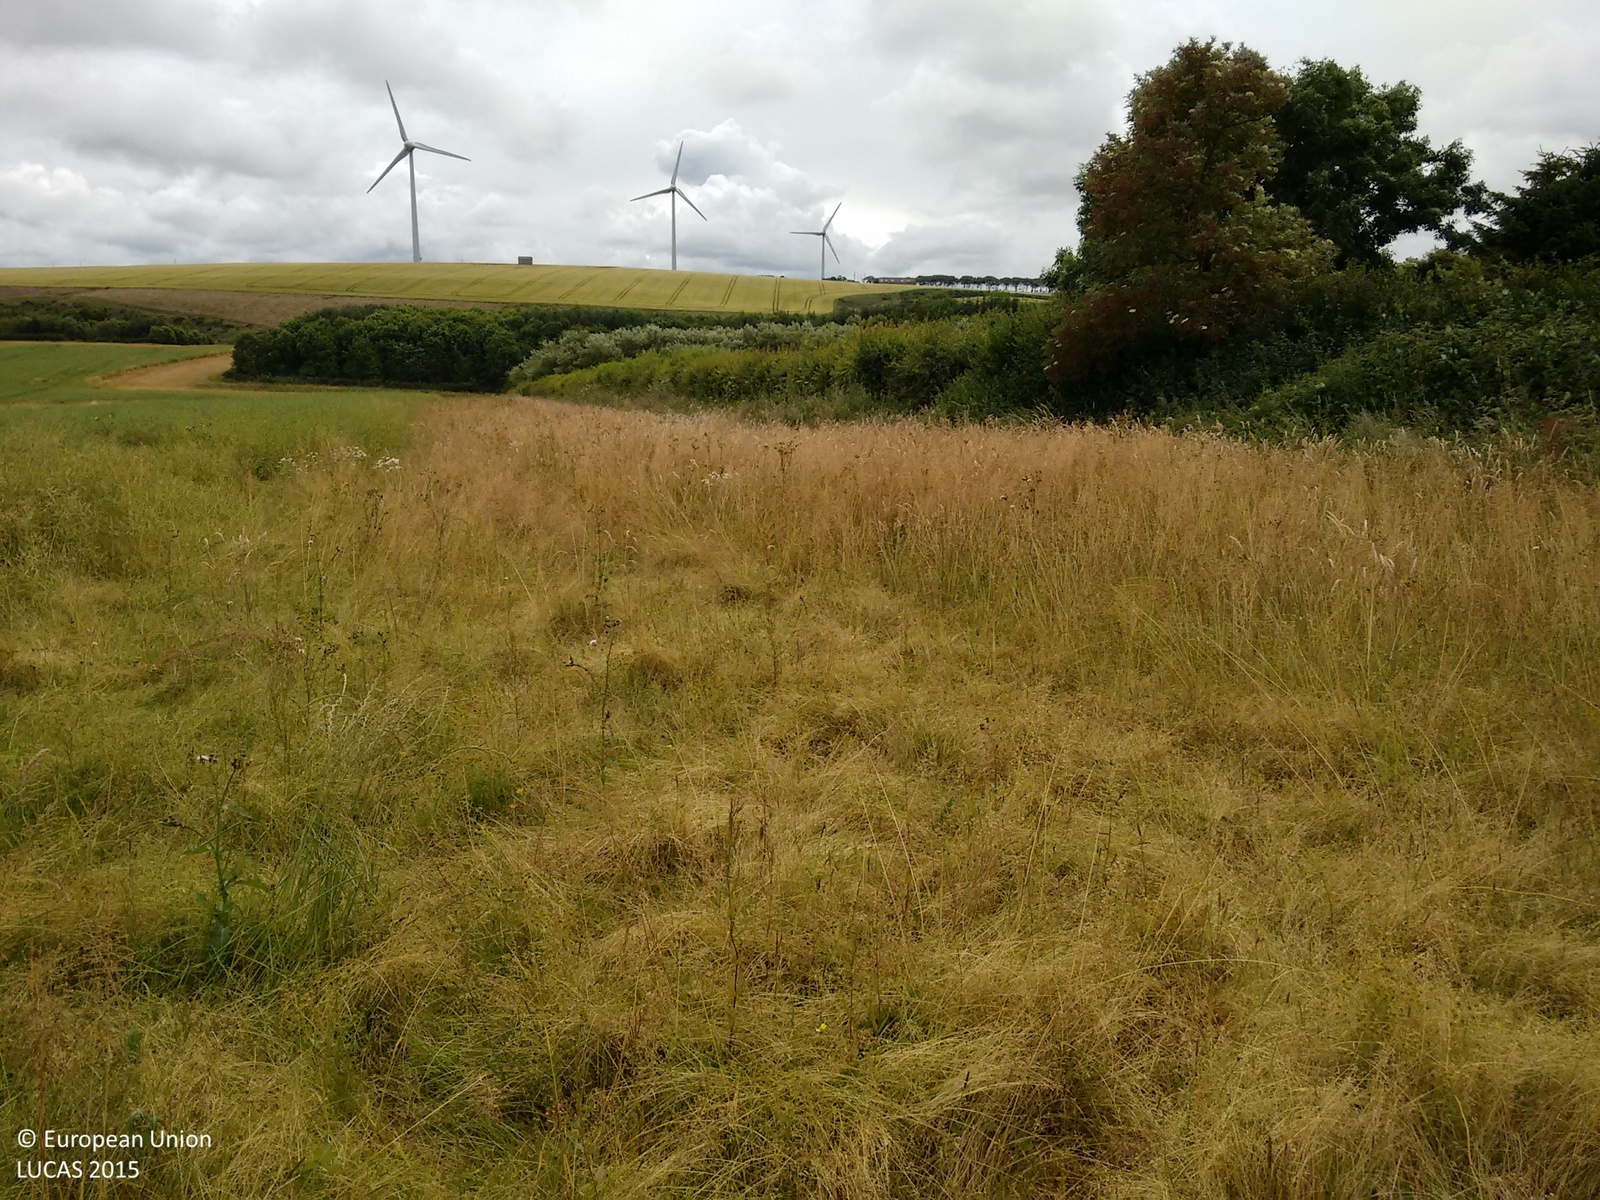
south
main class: Cropland
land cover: Rape and turnip rape
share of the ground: > 75 %
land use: Agriculture (excluding fallow land and kitchen gardens)
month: July
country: GB
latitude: 57.6043
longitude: -2.4181
